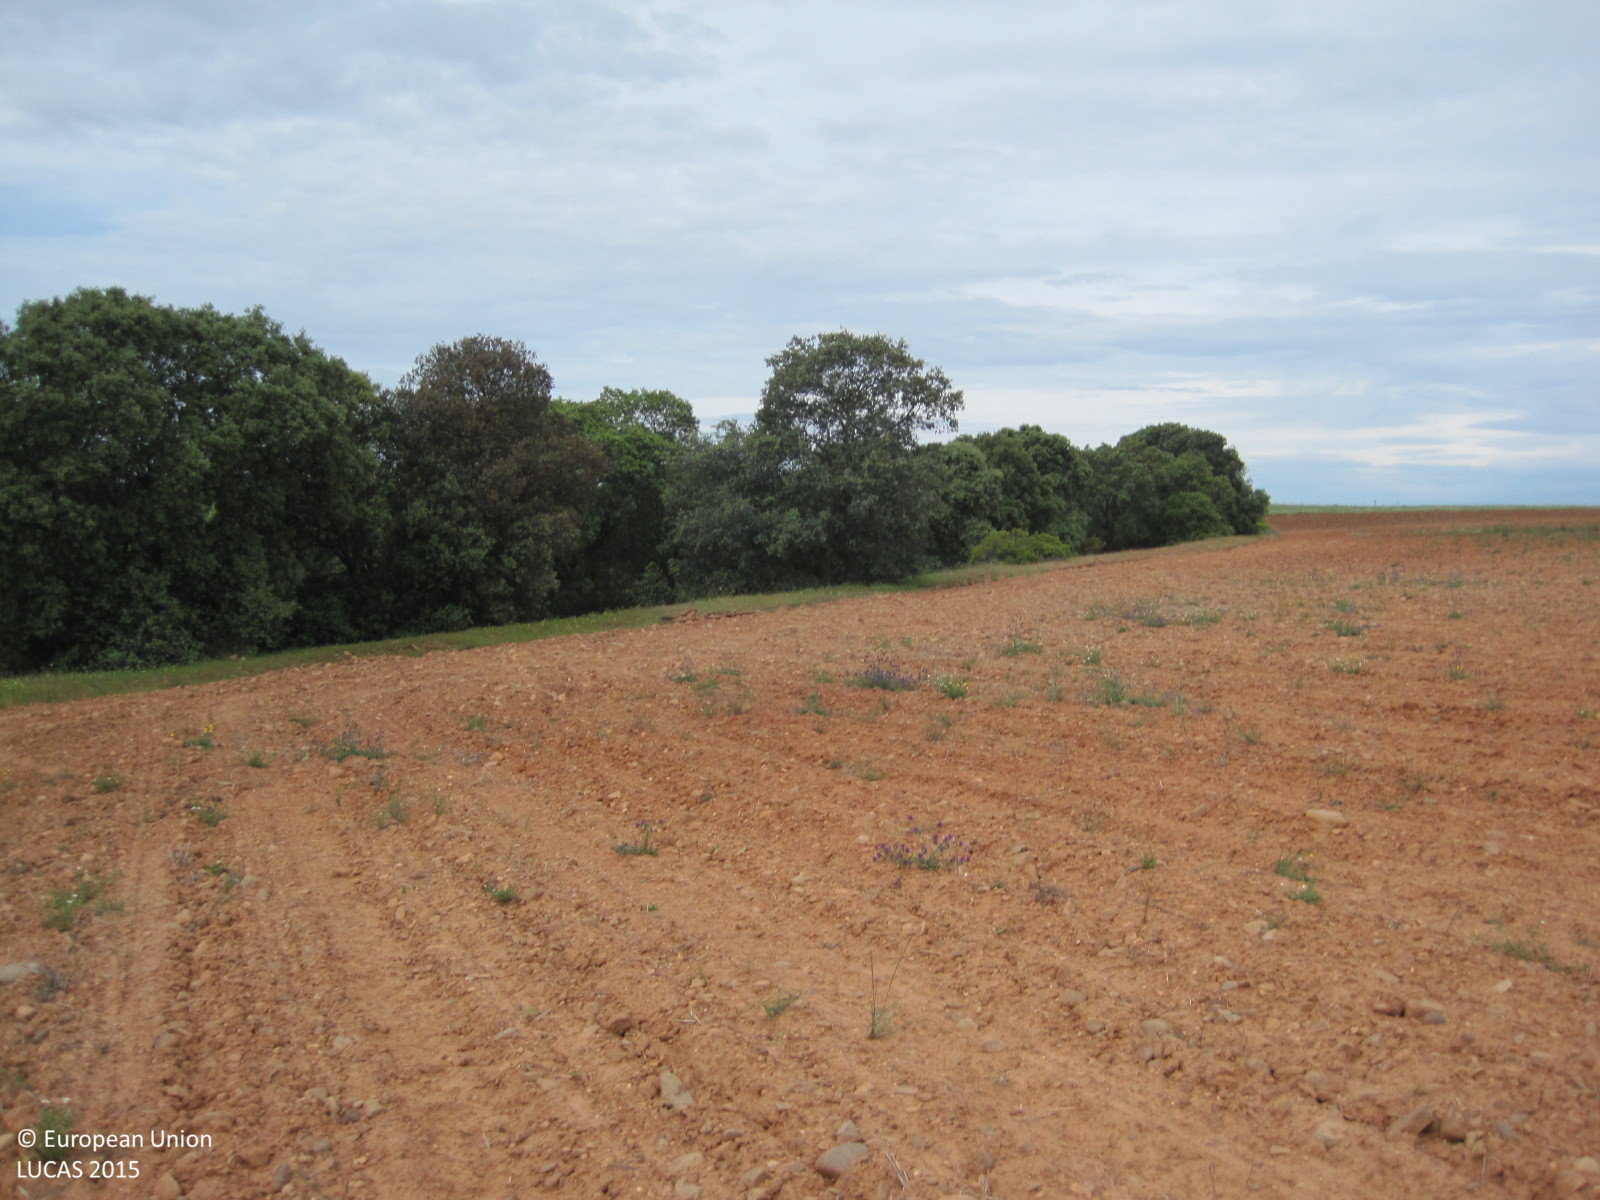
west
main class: Cropland
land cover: Sunflower
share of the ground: < 10 %
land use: Agriculture (excluding fallow land and kitchen gardens)
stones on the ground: 25 - 50 %
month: May
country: ES
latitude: 39.9164
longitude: -4.7515
